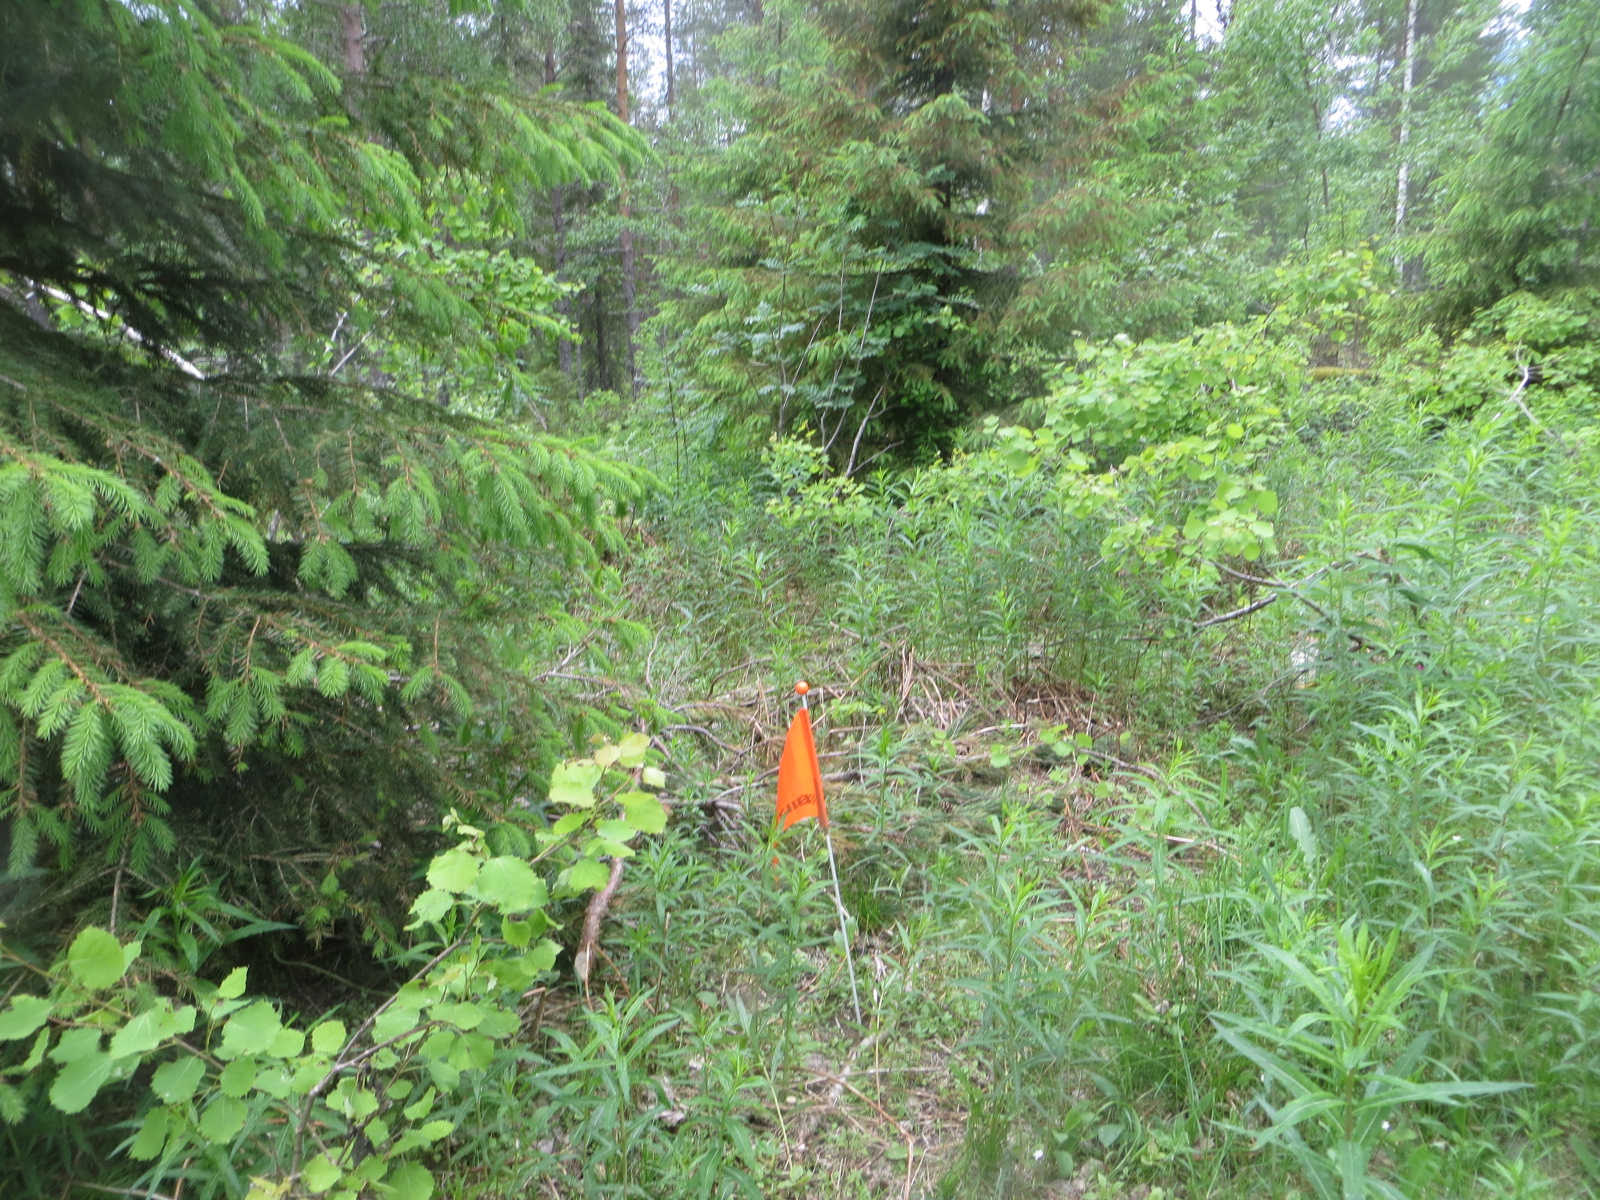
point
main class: Woodland
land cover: Spruce dominated mixed woodland
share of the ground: 25 - 50 %
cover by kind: herbaceous plants 40 %, coniferous forest trees 30 %, shrubs 20 %, broadleaved forest trees 10 %
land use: Forestry
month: June
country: FI
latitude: 65.6279
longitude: 26.6300
